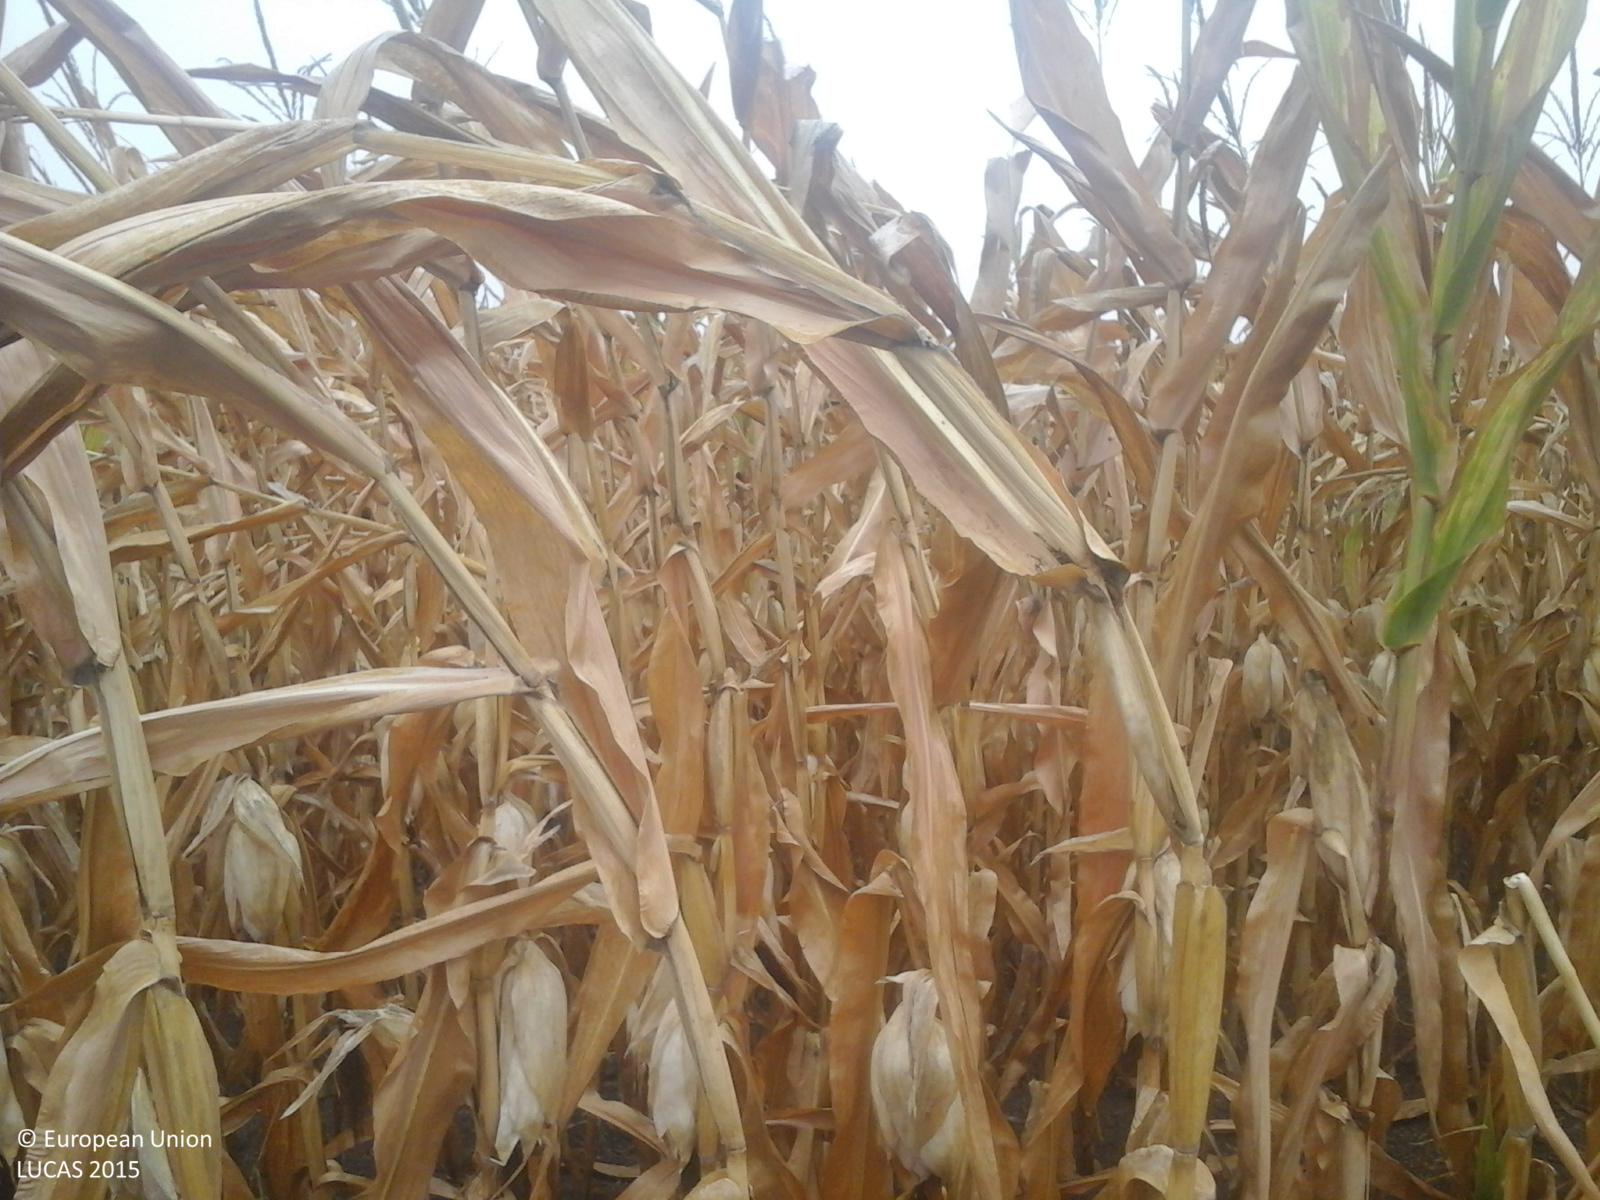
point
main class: Cropland
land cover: Maize
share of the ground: > 75 %
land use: Agriculture (excluding fallow land and kitchen gardens)
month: September
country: RO
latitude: 47.7007
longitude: 22.5722
